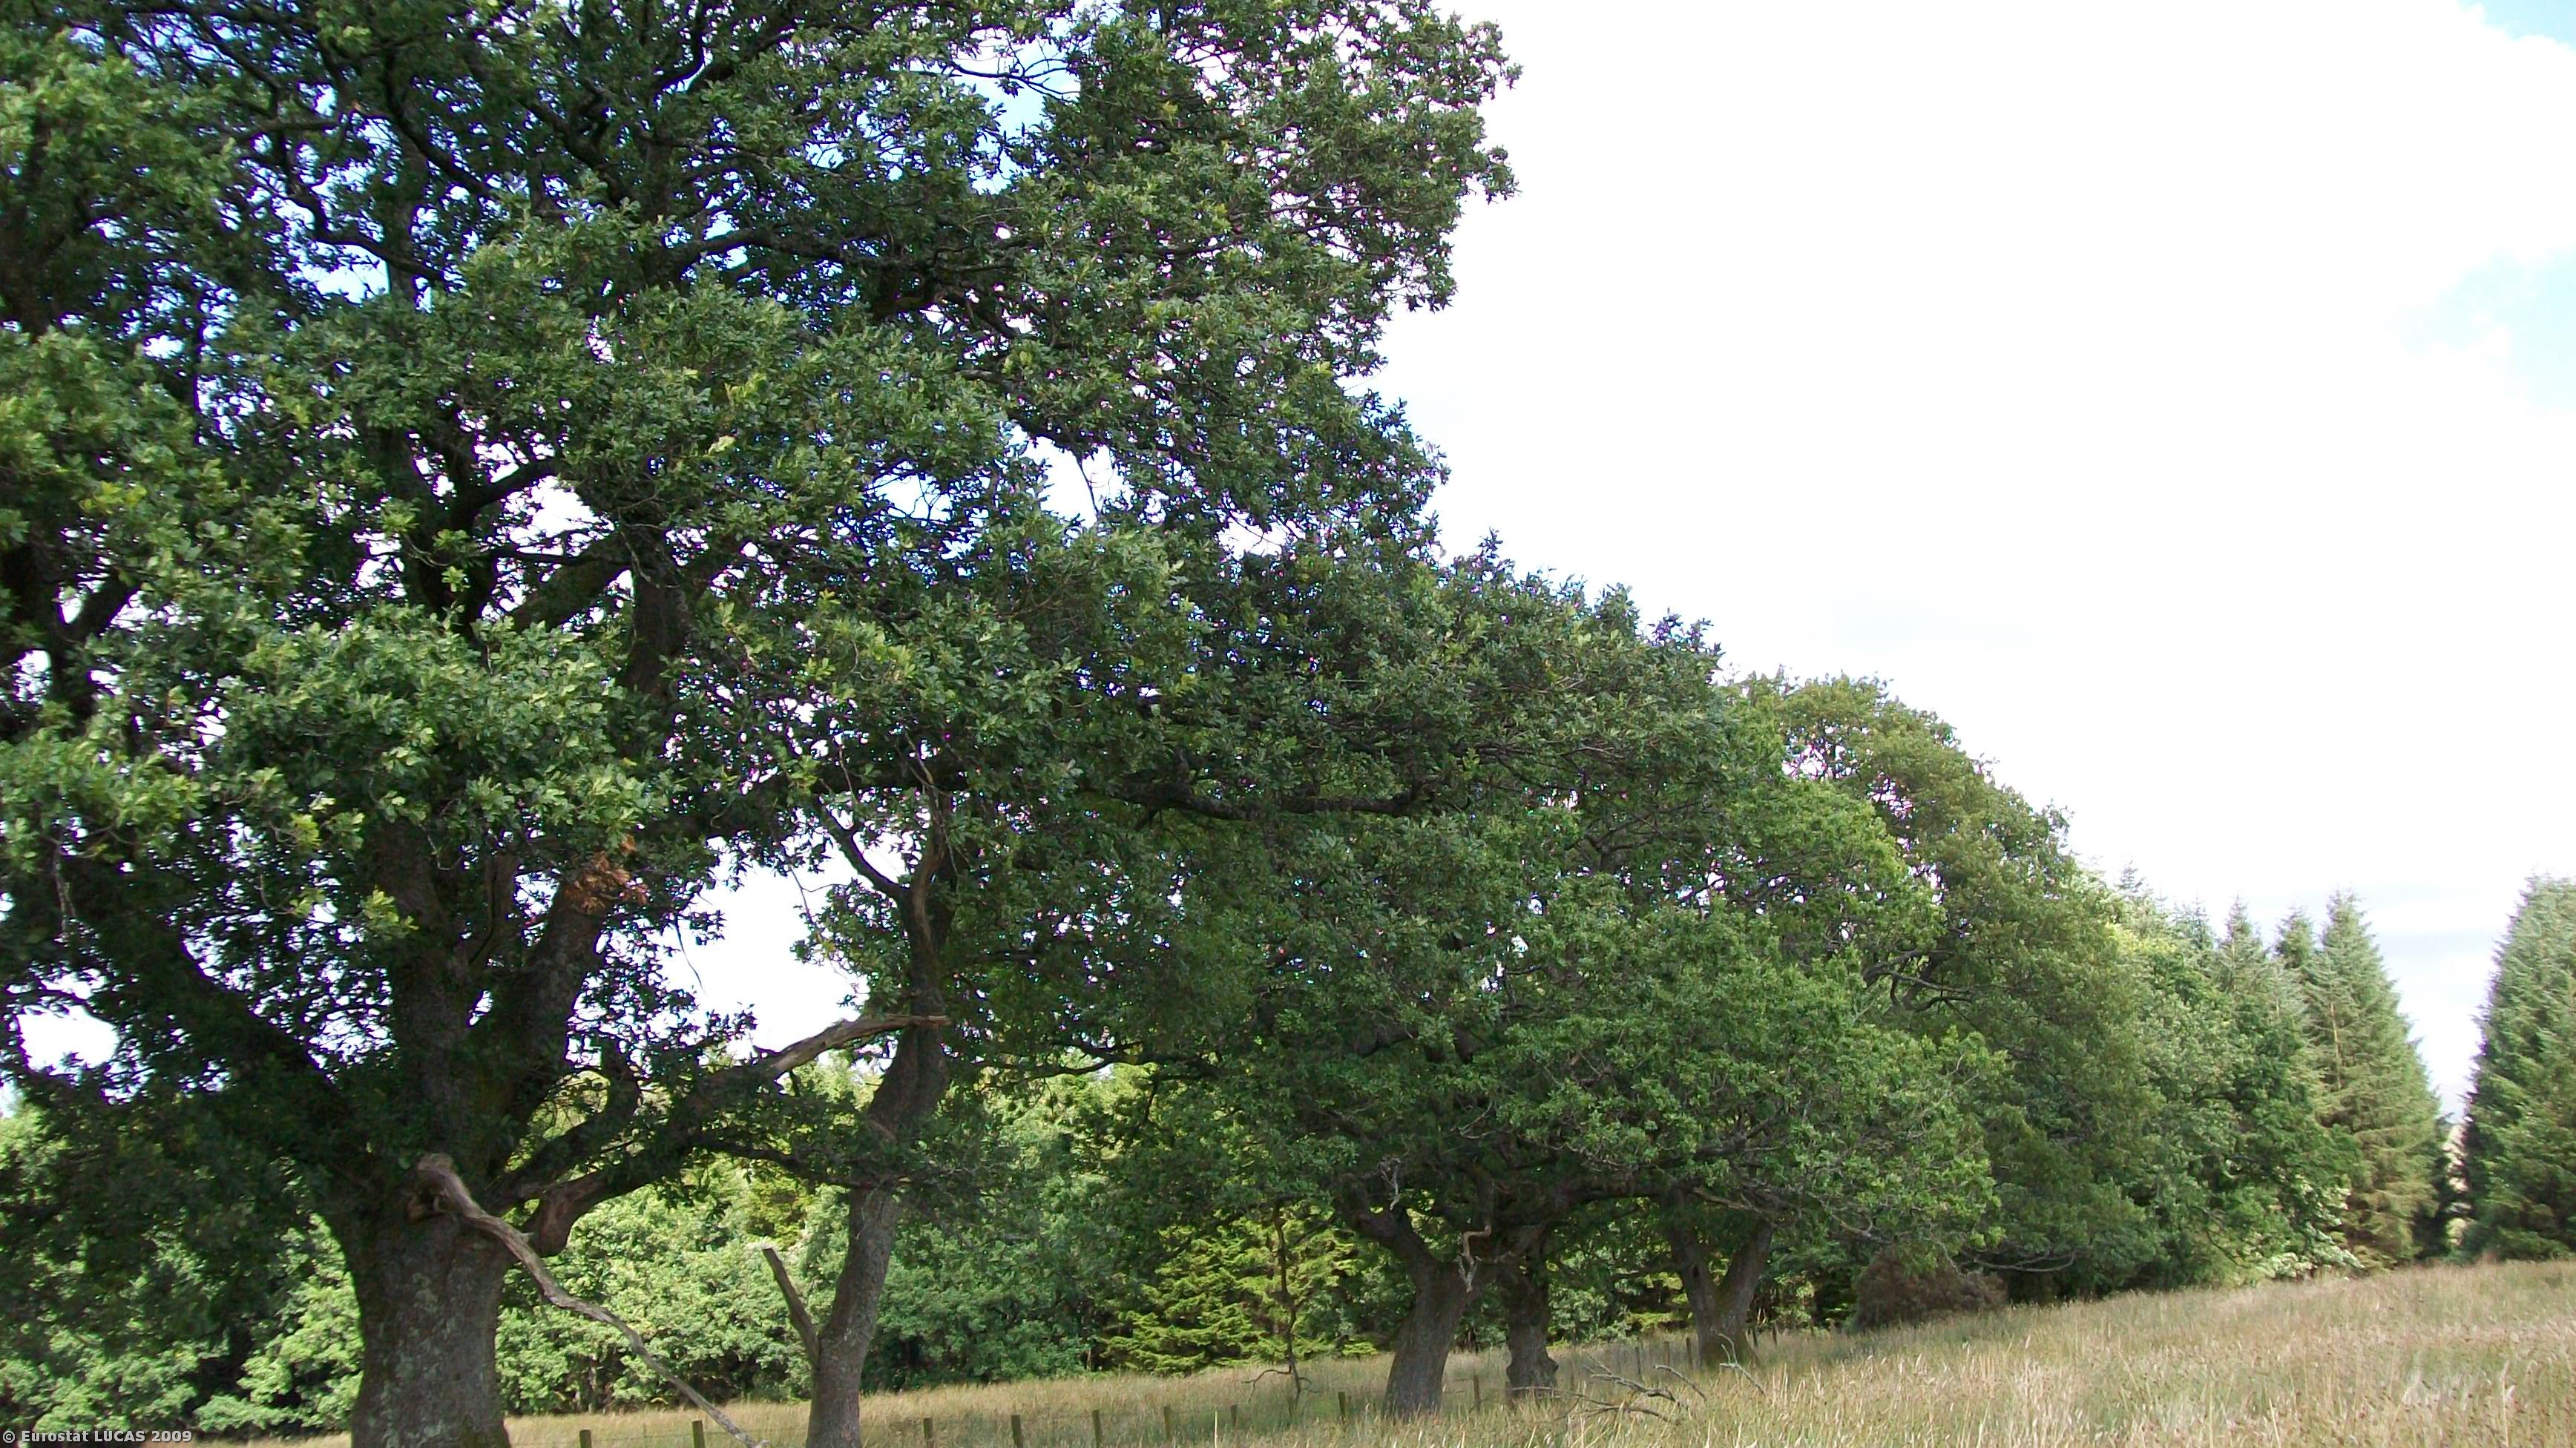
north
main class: Grassland
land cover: Grassland without tree/shrub cover
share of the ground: > 75 %
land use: Agriculture (excluding fallow land and kitchen gardens)
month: August
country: GB
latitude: 55.2082
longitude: -3.3880
